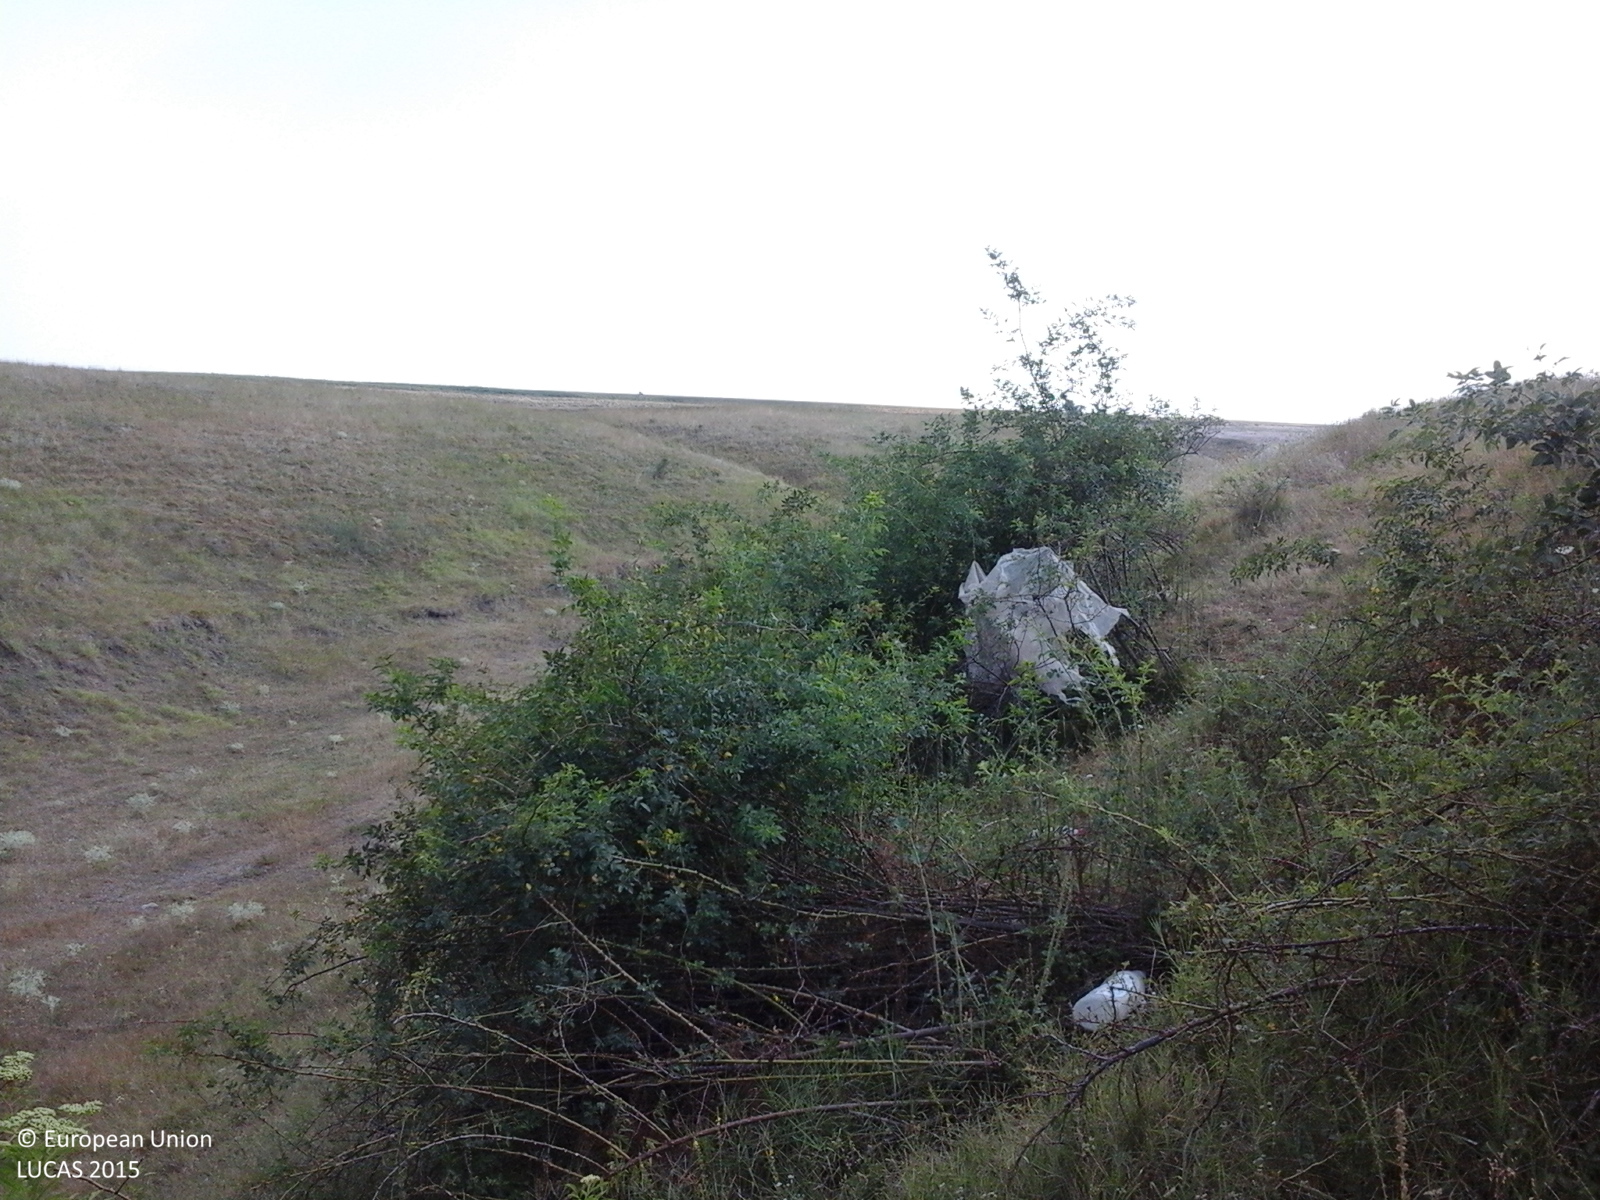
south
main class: Shrubland
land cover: Shrubland with sparse tree cover
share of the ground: > 75 %
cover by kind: herbaceous plants 60 %, shrubs 35 %, broadleaved forest trees 5 %
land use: Agriculture (excluding fallow land and kitchen gardens)
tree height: > 5 m
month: July
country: RO
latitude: 45.8821
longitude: 27.6467
